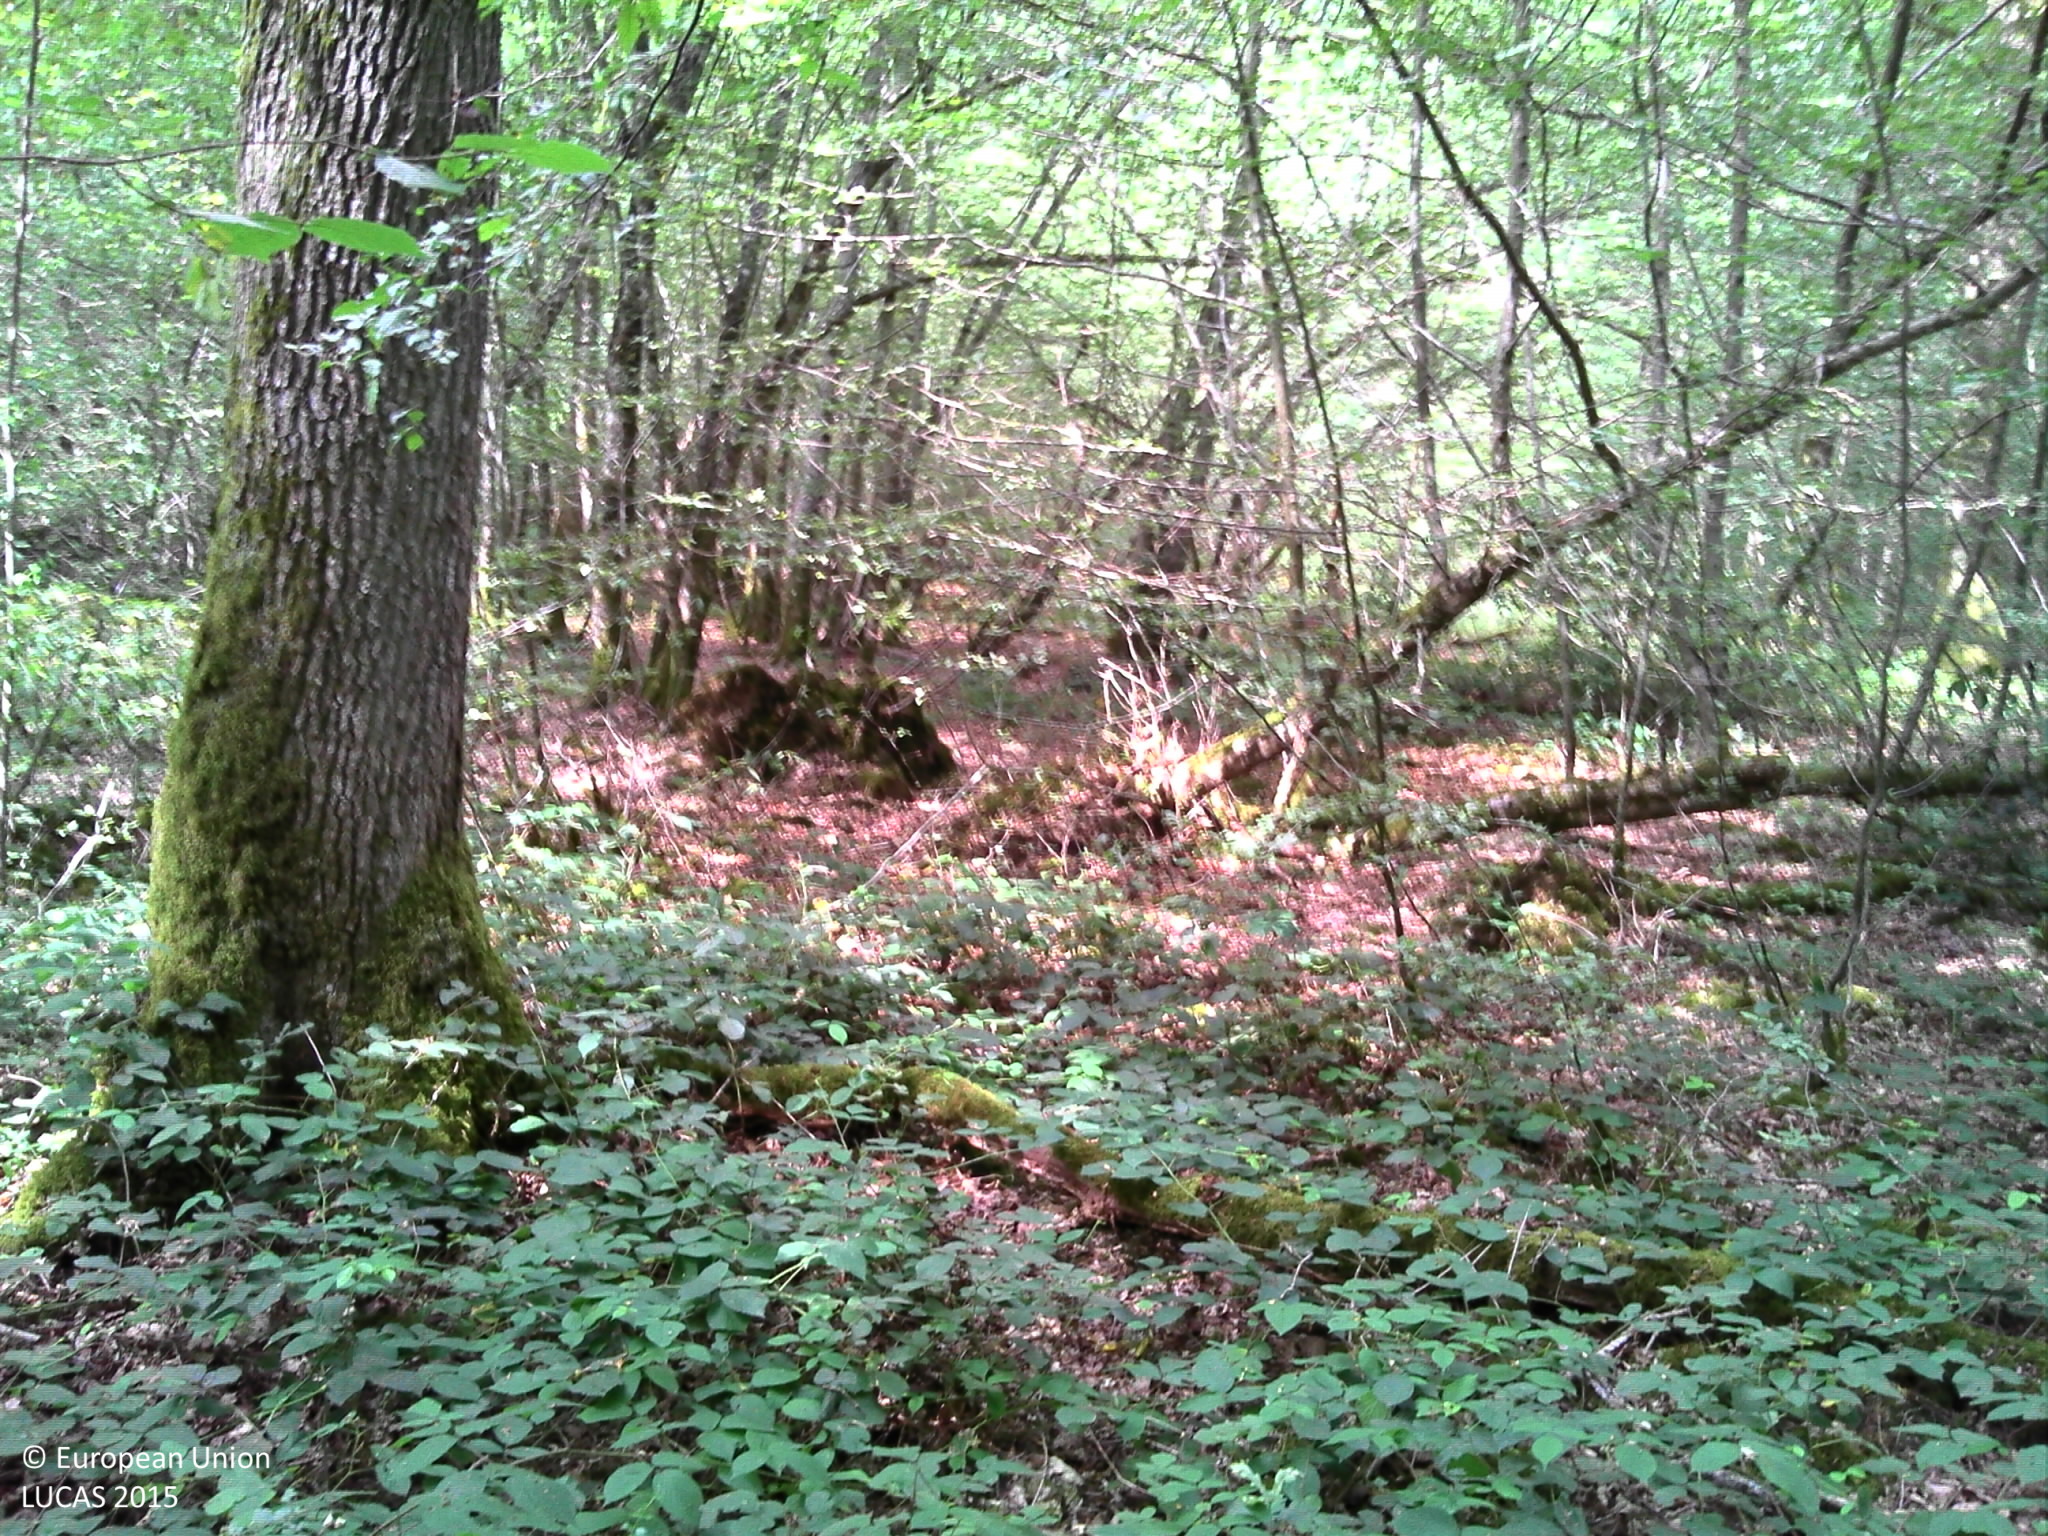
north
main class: Woodland
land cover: Broadleaved woodland
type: mesophytic deciduous forest
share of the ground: > 75 %
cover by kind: broadleaved forest trees 90 %, herbaceous plants 5 %, lichens and mosses 5 %
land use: Forestry
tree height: > 5 m
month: July
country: FR
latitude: 48.0766
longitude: 3.0536
